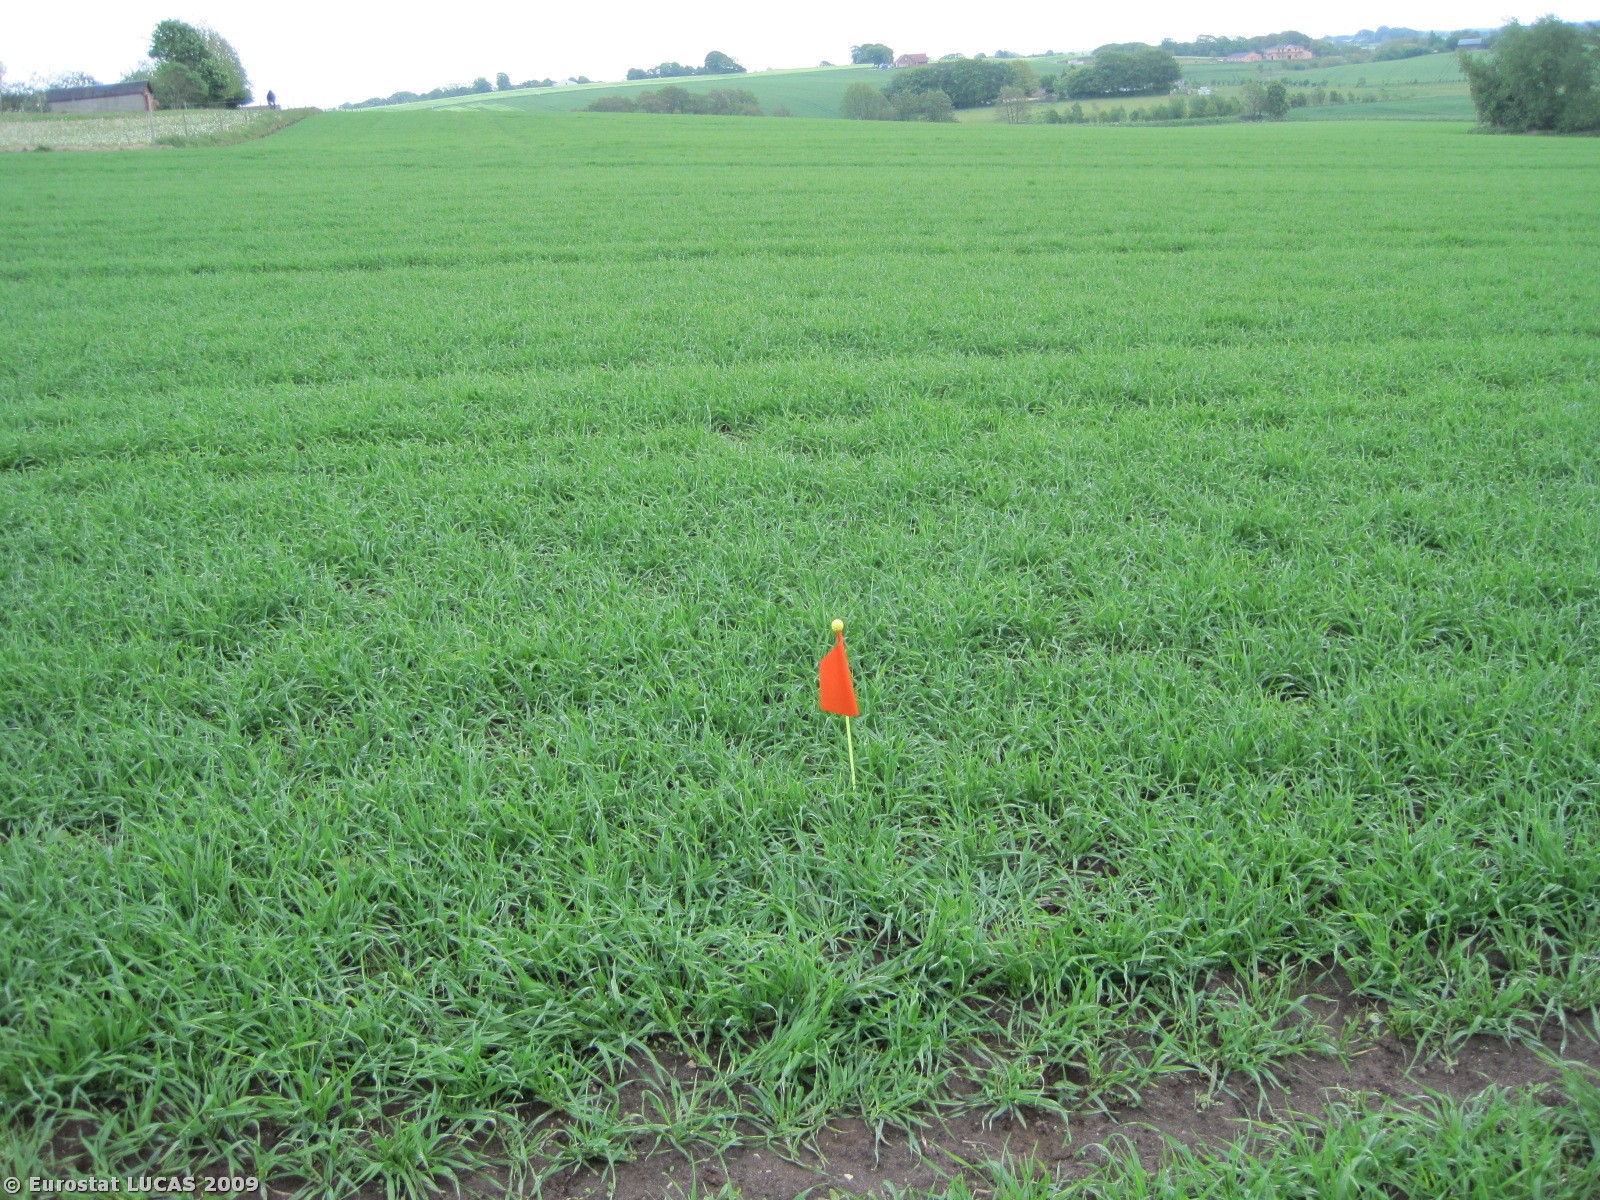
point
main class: Cropland
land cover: Barley
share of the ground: > 75 %
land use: Agriculture (excluding fallow land and kitchen gardens)
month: May
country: DK
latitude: 56.3493
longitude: 9.7576
